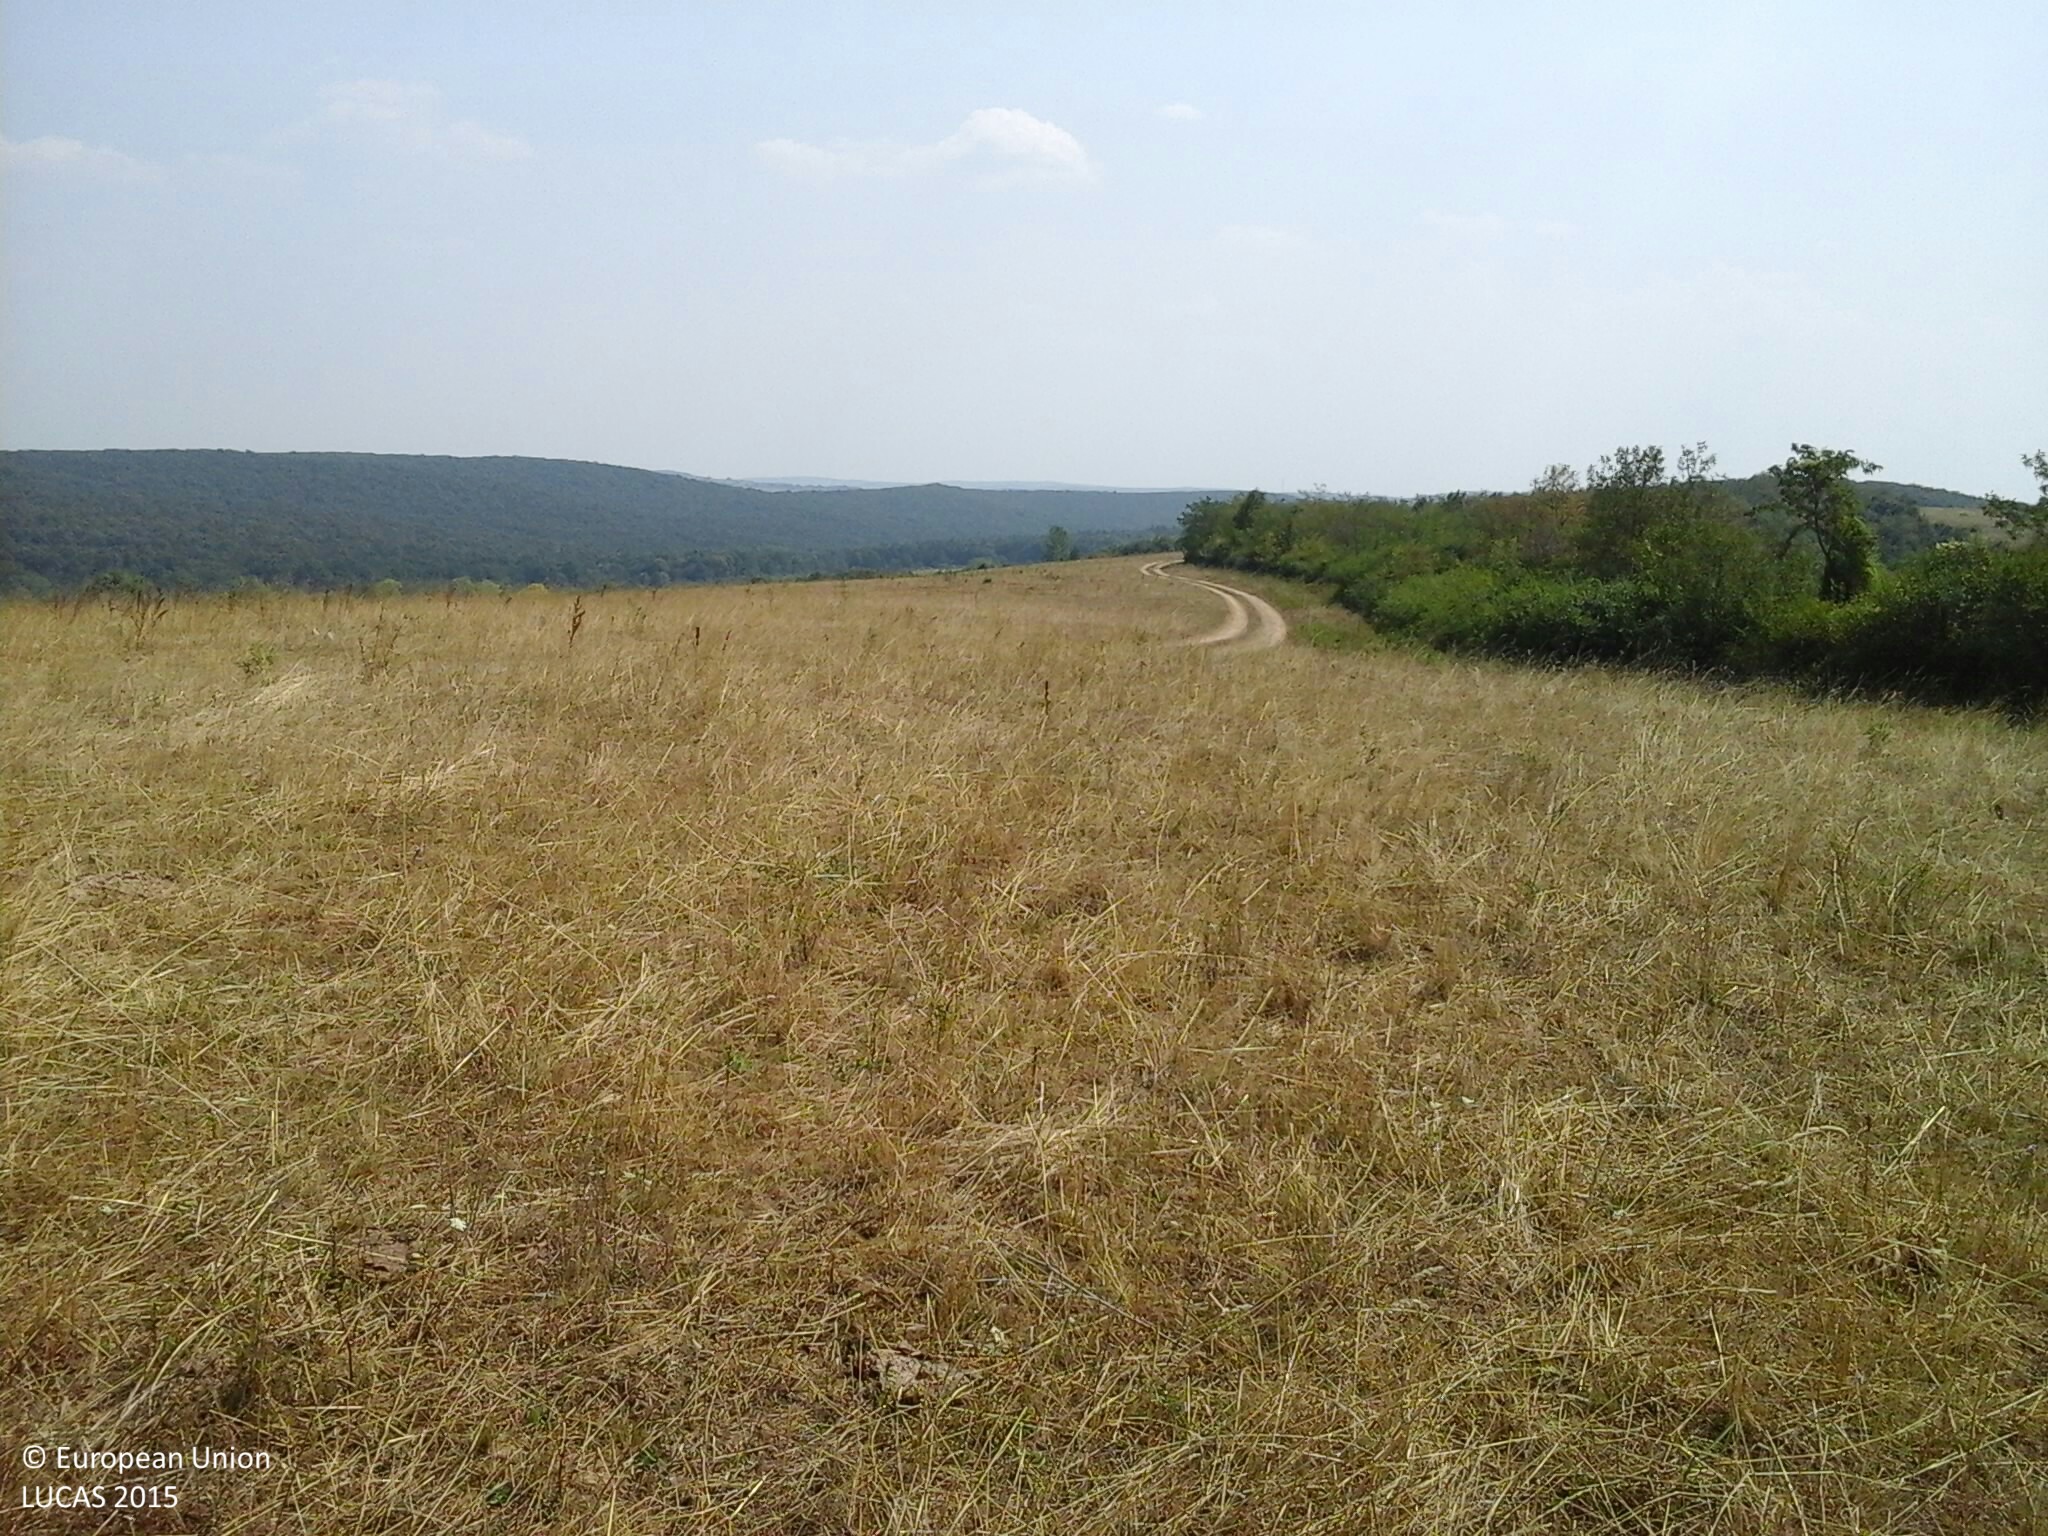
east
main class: Grassland
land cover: Grassland without tree/shrub cover
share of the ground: > 75 %
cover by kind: herbaceous plants 100 %
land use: Agriculture (excluding fallow land and kitchen gardens)
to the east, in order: Grassland without tree/shrub cover; Tracks; Grassland without tree/shrub cover
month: August
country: HU
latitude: 48.4071
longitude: 20.5314
